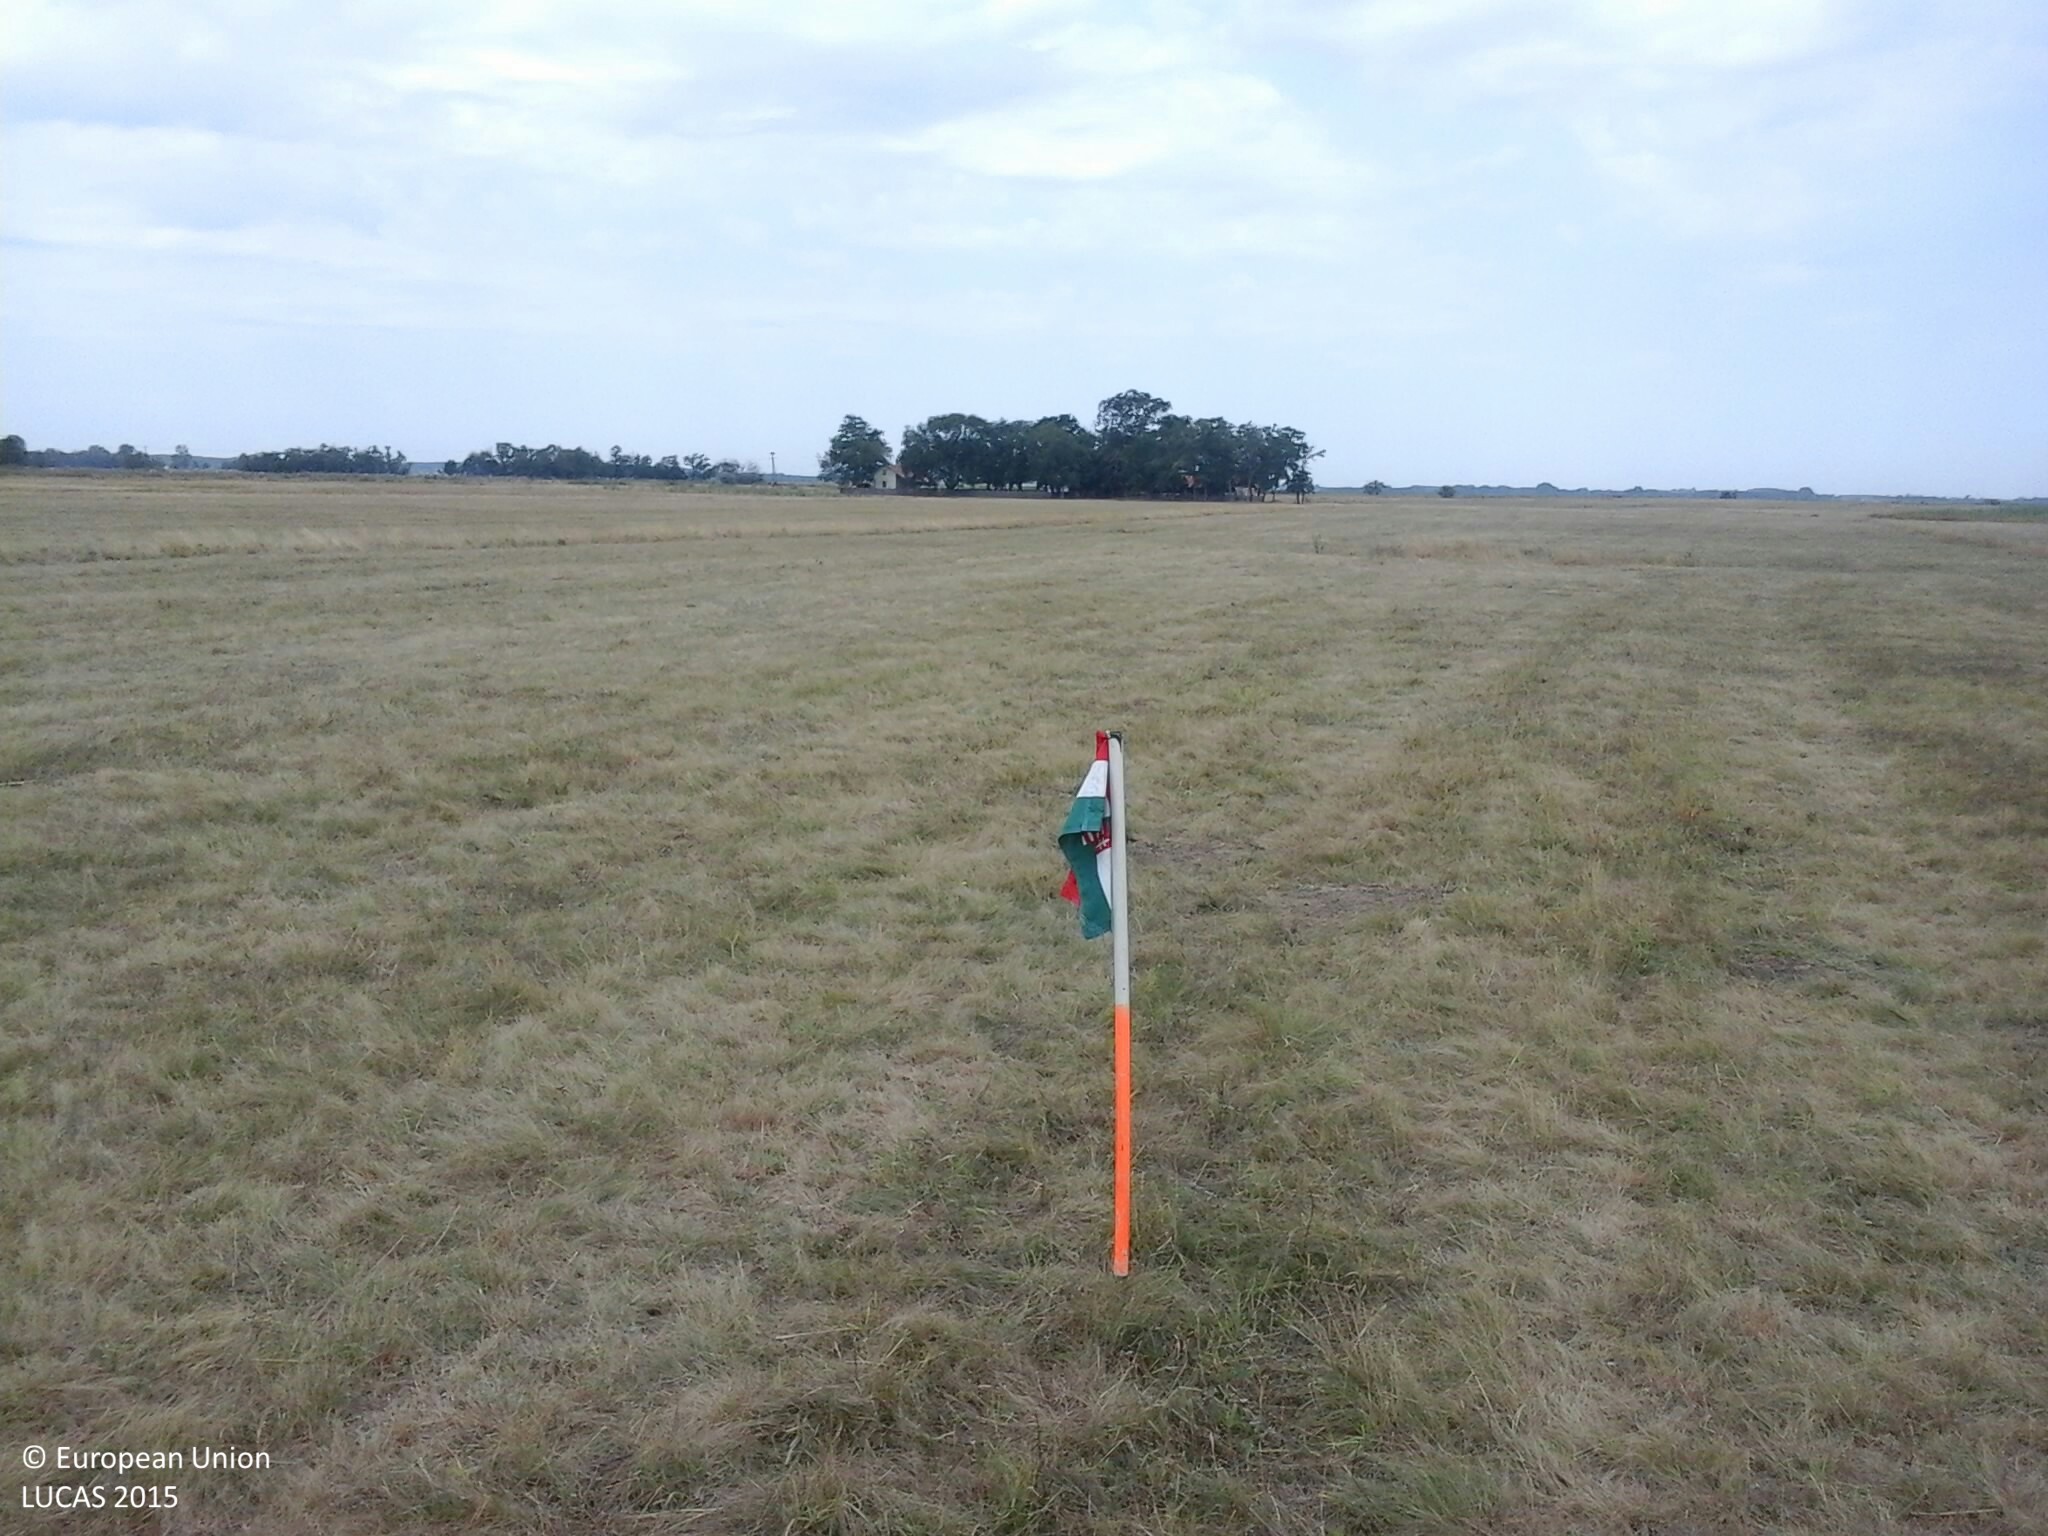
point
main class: Grassland
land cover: Grassland without tree/shrub cover
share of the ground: > 75 %
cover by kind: herbaceous plants 100 %
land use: Agriculture (excluding fallow land and kitchen gardens)
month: July
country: HU
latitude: 46.5276
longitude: 20.0739
